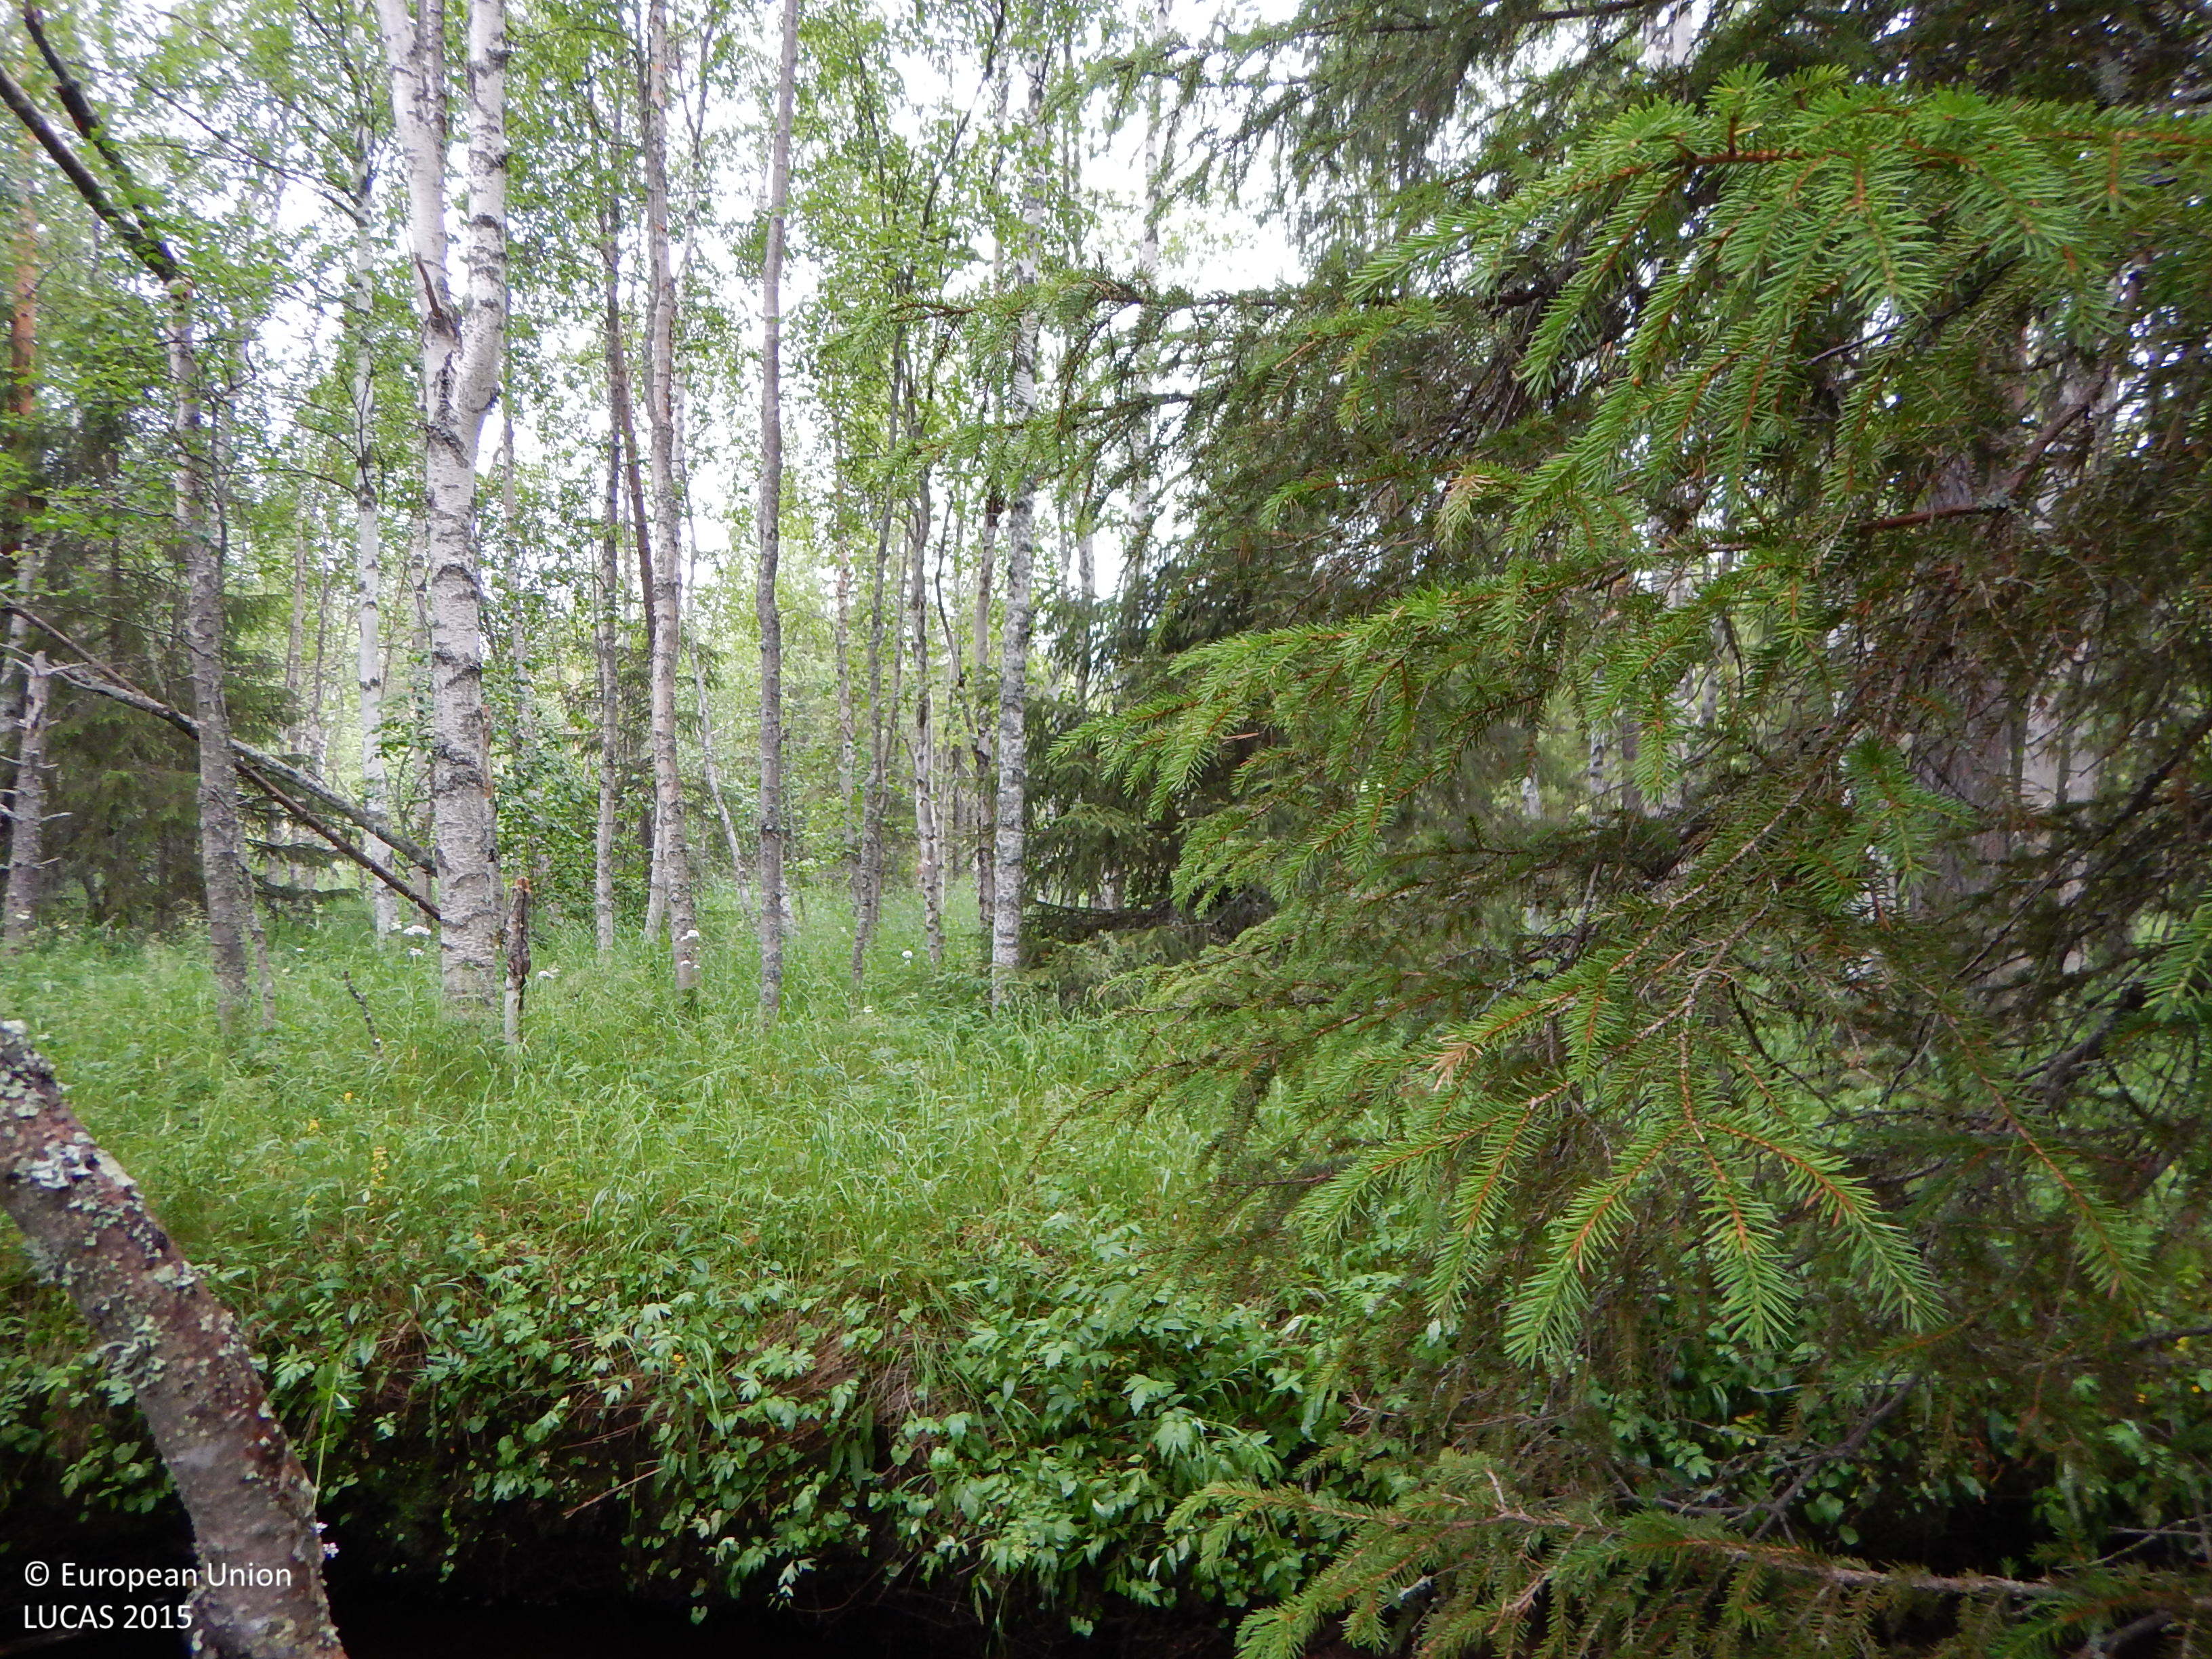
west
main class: Woodland
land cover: Other mixed woodland
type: boreal forest
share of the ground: 50 - 75 %
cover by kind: broadleaved forest trees 40 %, herbaceous plants 20 %, coniferous forest trees 15 %, lichens and mosses 15 %, shrubs 10 %
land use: Forestry
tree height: > 5 m
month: July
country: SE
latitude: 64.9853
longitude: 20.4210
